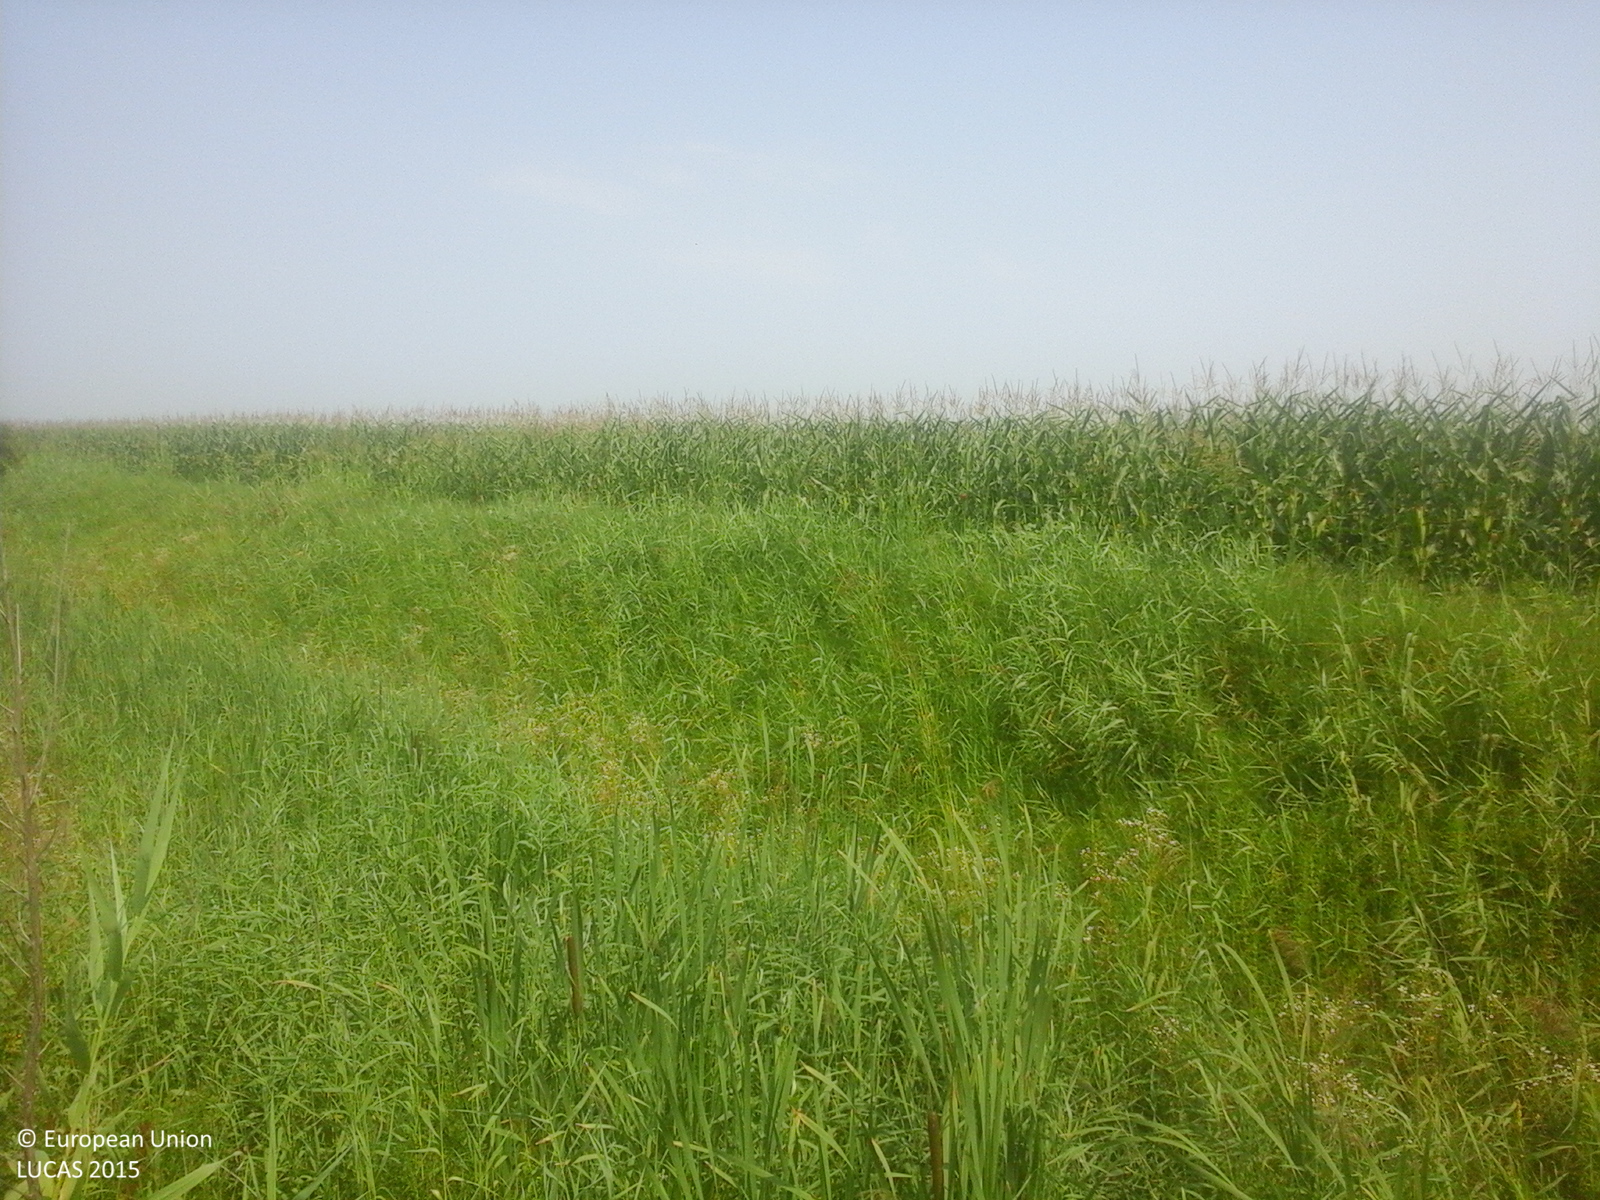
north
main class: Cropland
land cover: Maize
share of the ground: > 75 %
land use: Agriculture (excluding fallow land and kitchen gardens)
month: July
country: RO
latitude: 44.7562
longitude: 26.3212
